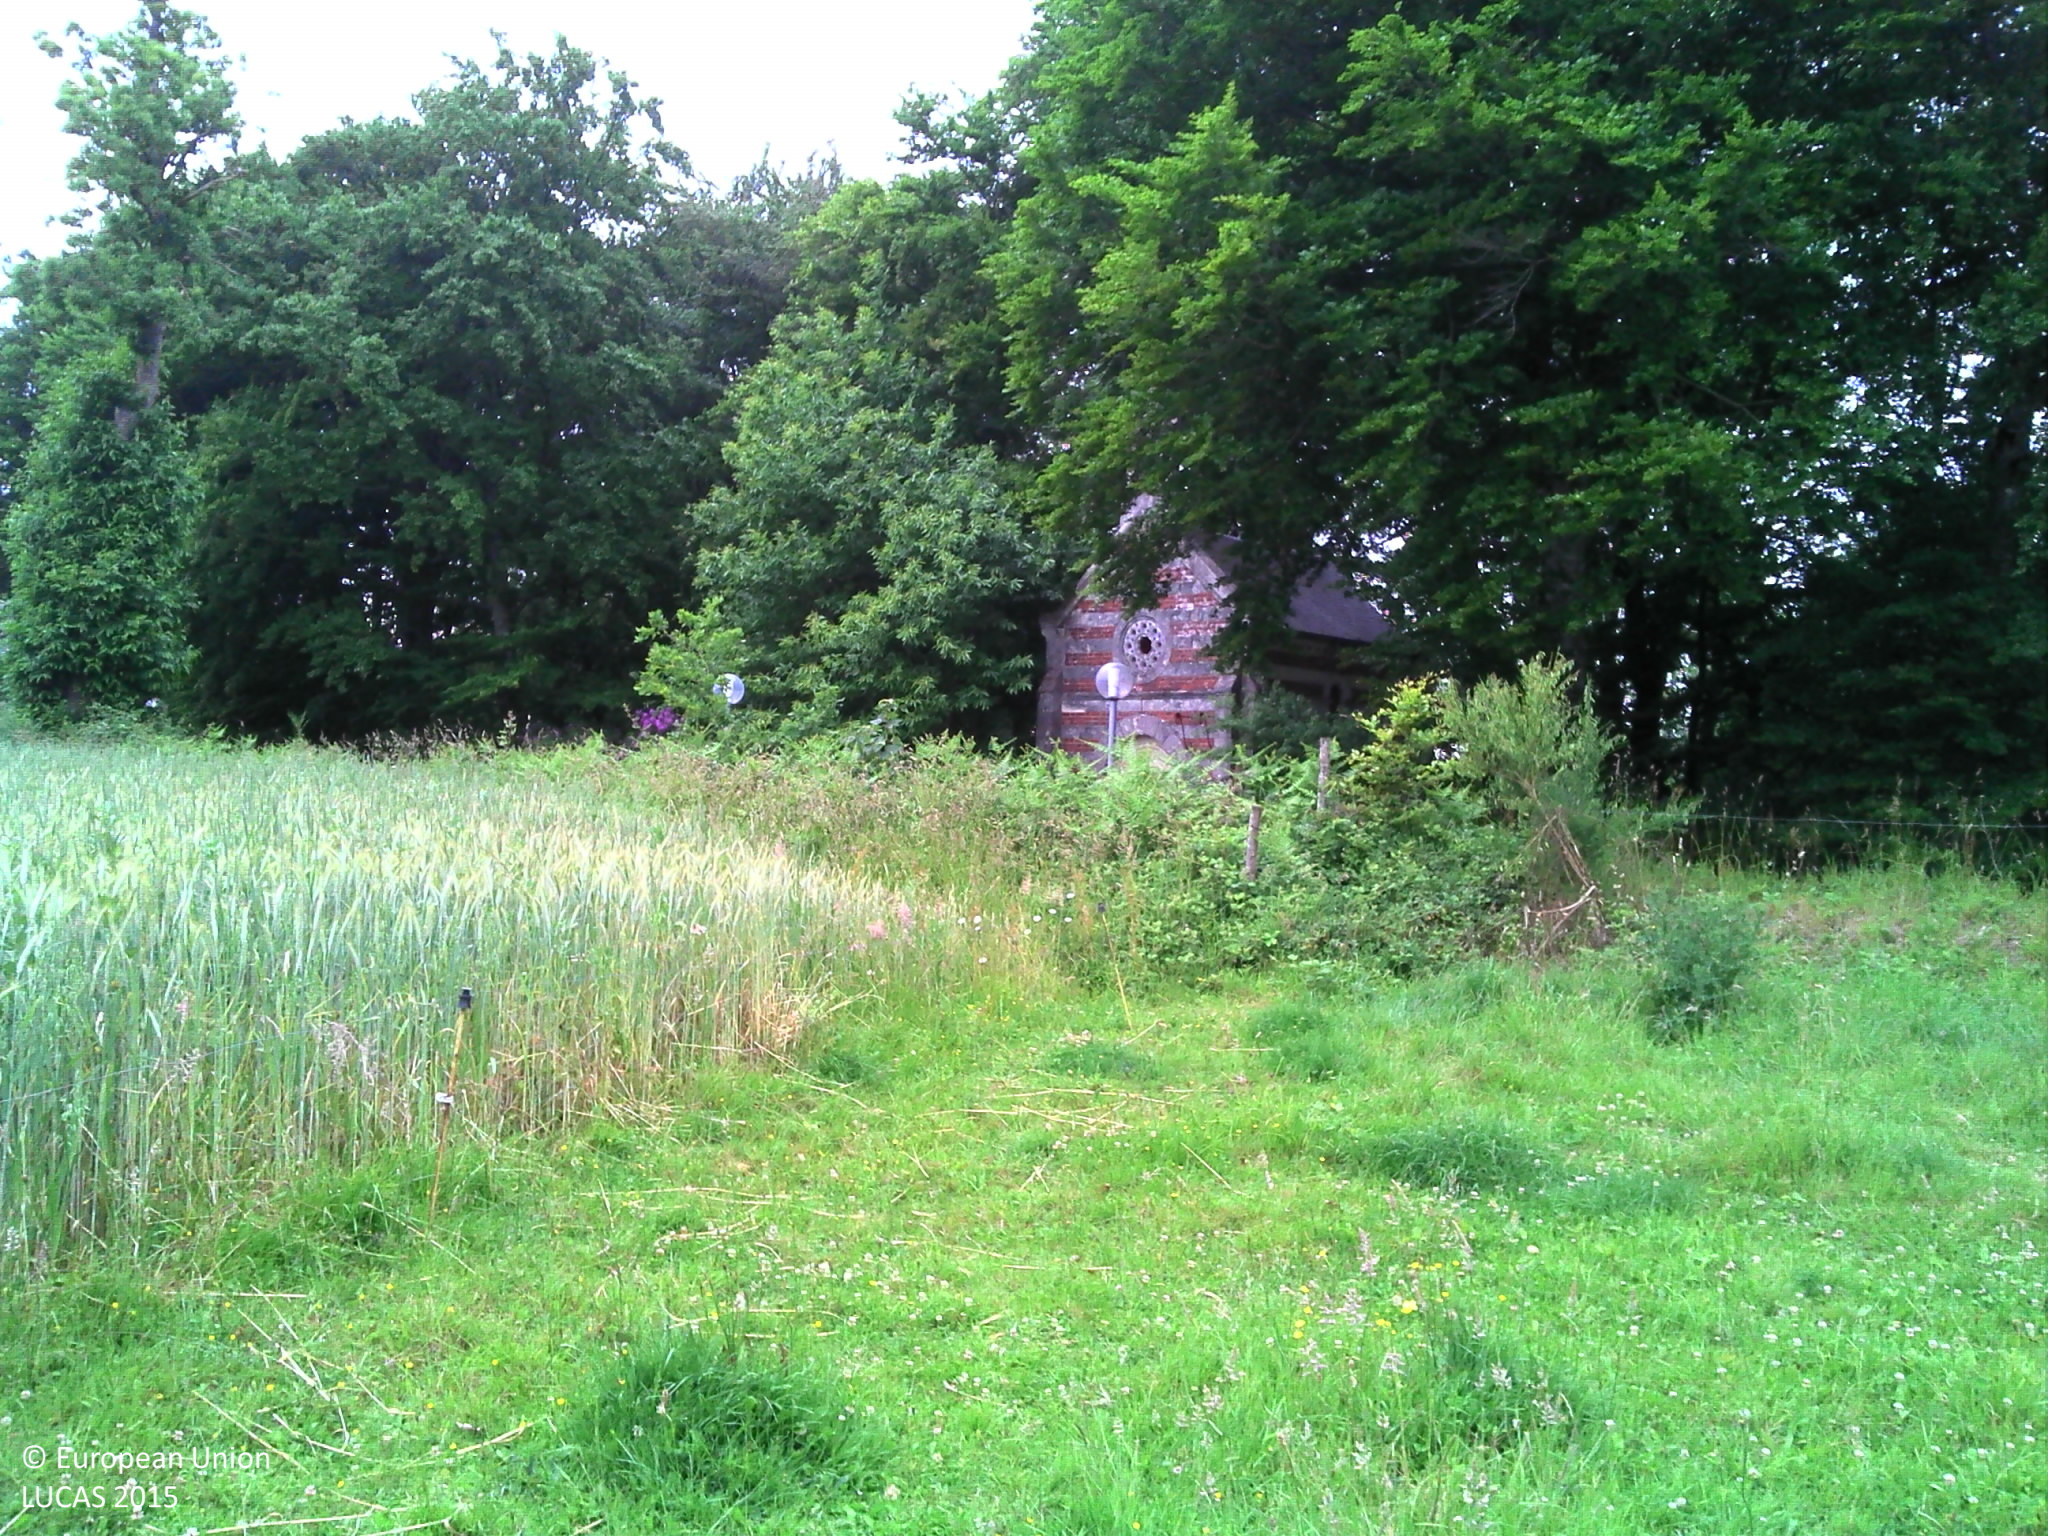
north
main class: Cropland
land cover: Apple fruit
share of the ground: 10 - 25 %
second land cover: Grassland without tree/shrub cover
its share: > 75 %
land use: Agriculture (excluding fallow land and kitchen gardens)
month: June
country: FR
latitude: 48.1668
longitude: -1.6517
